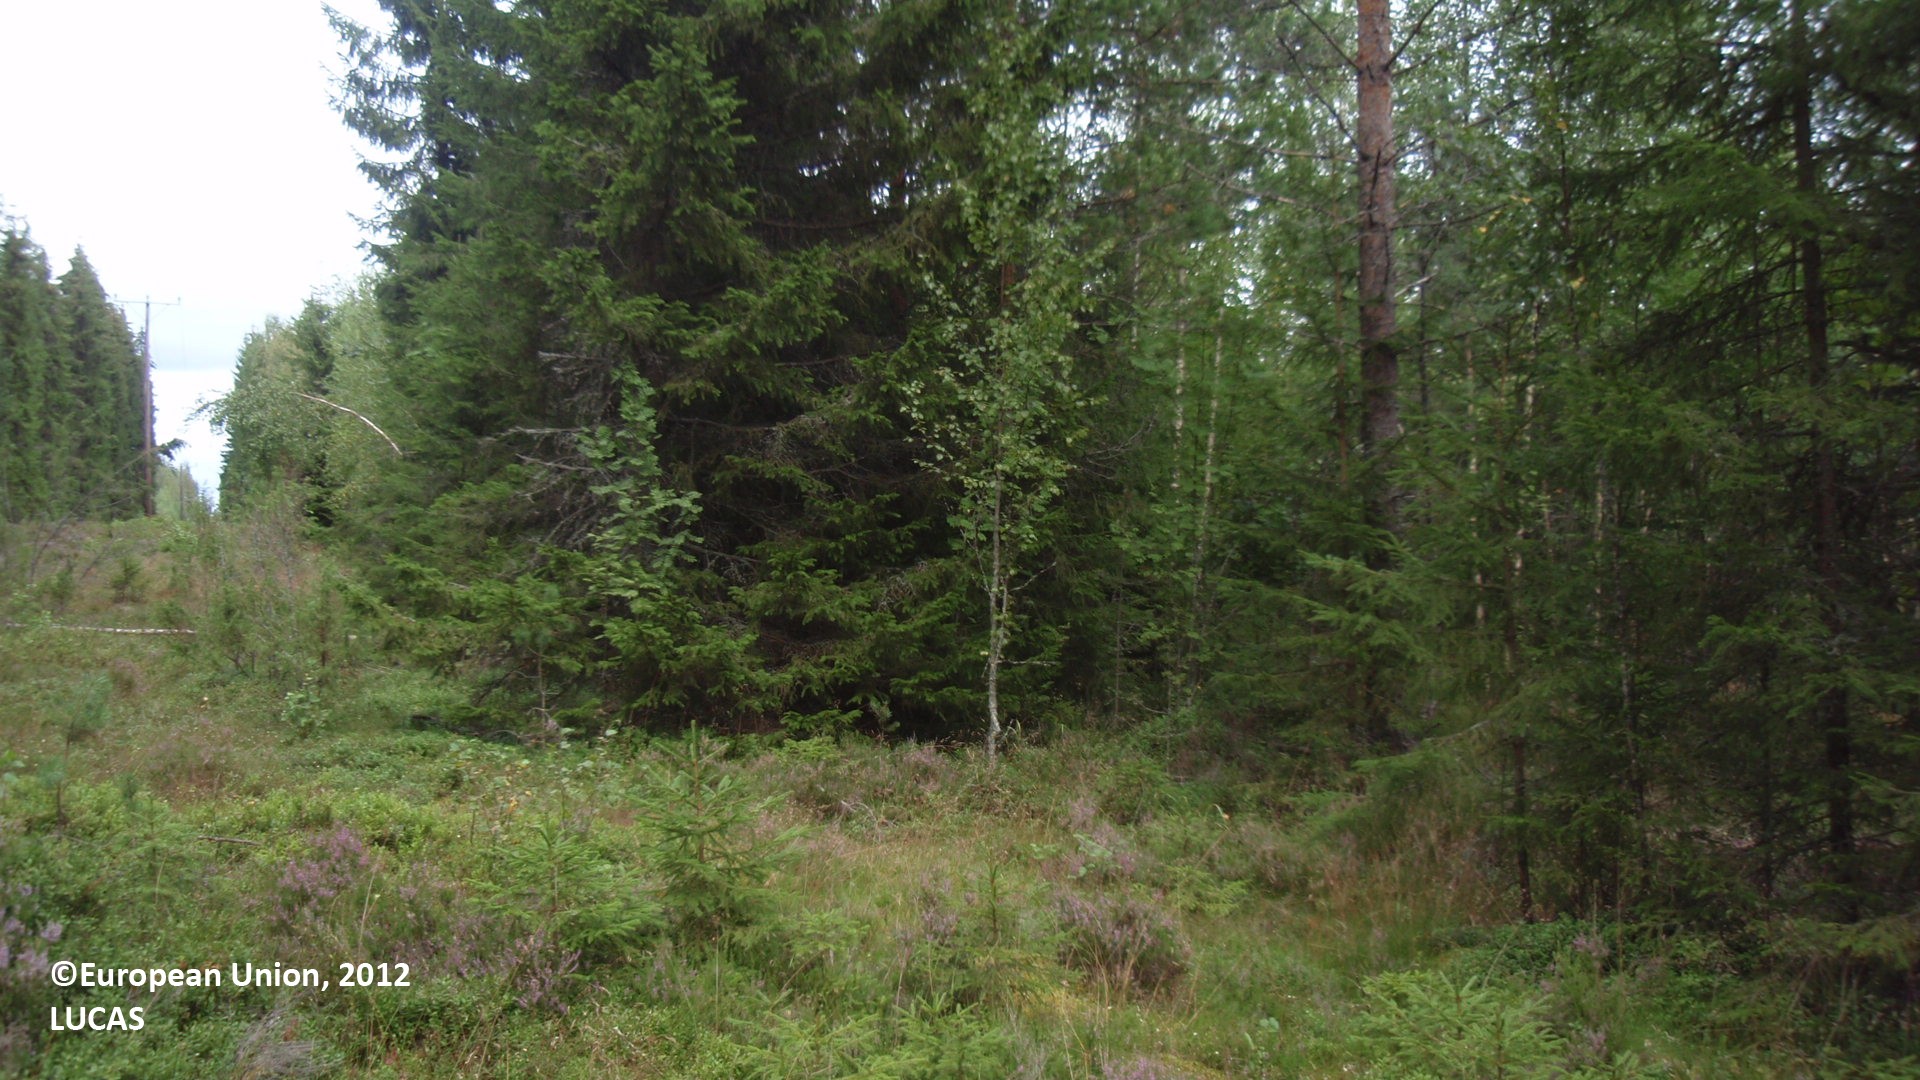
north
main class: Shrubland
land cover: Shrubland with sparse tree cover
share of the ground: > 75 %
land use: Forestry
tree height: < 5 m
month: August
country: FI
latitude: 61.0979
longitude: 27.6012
